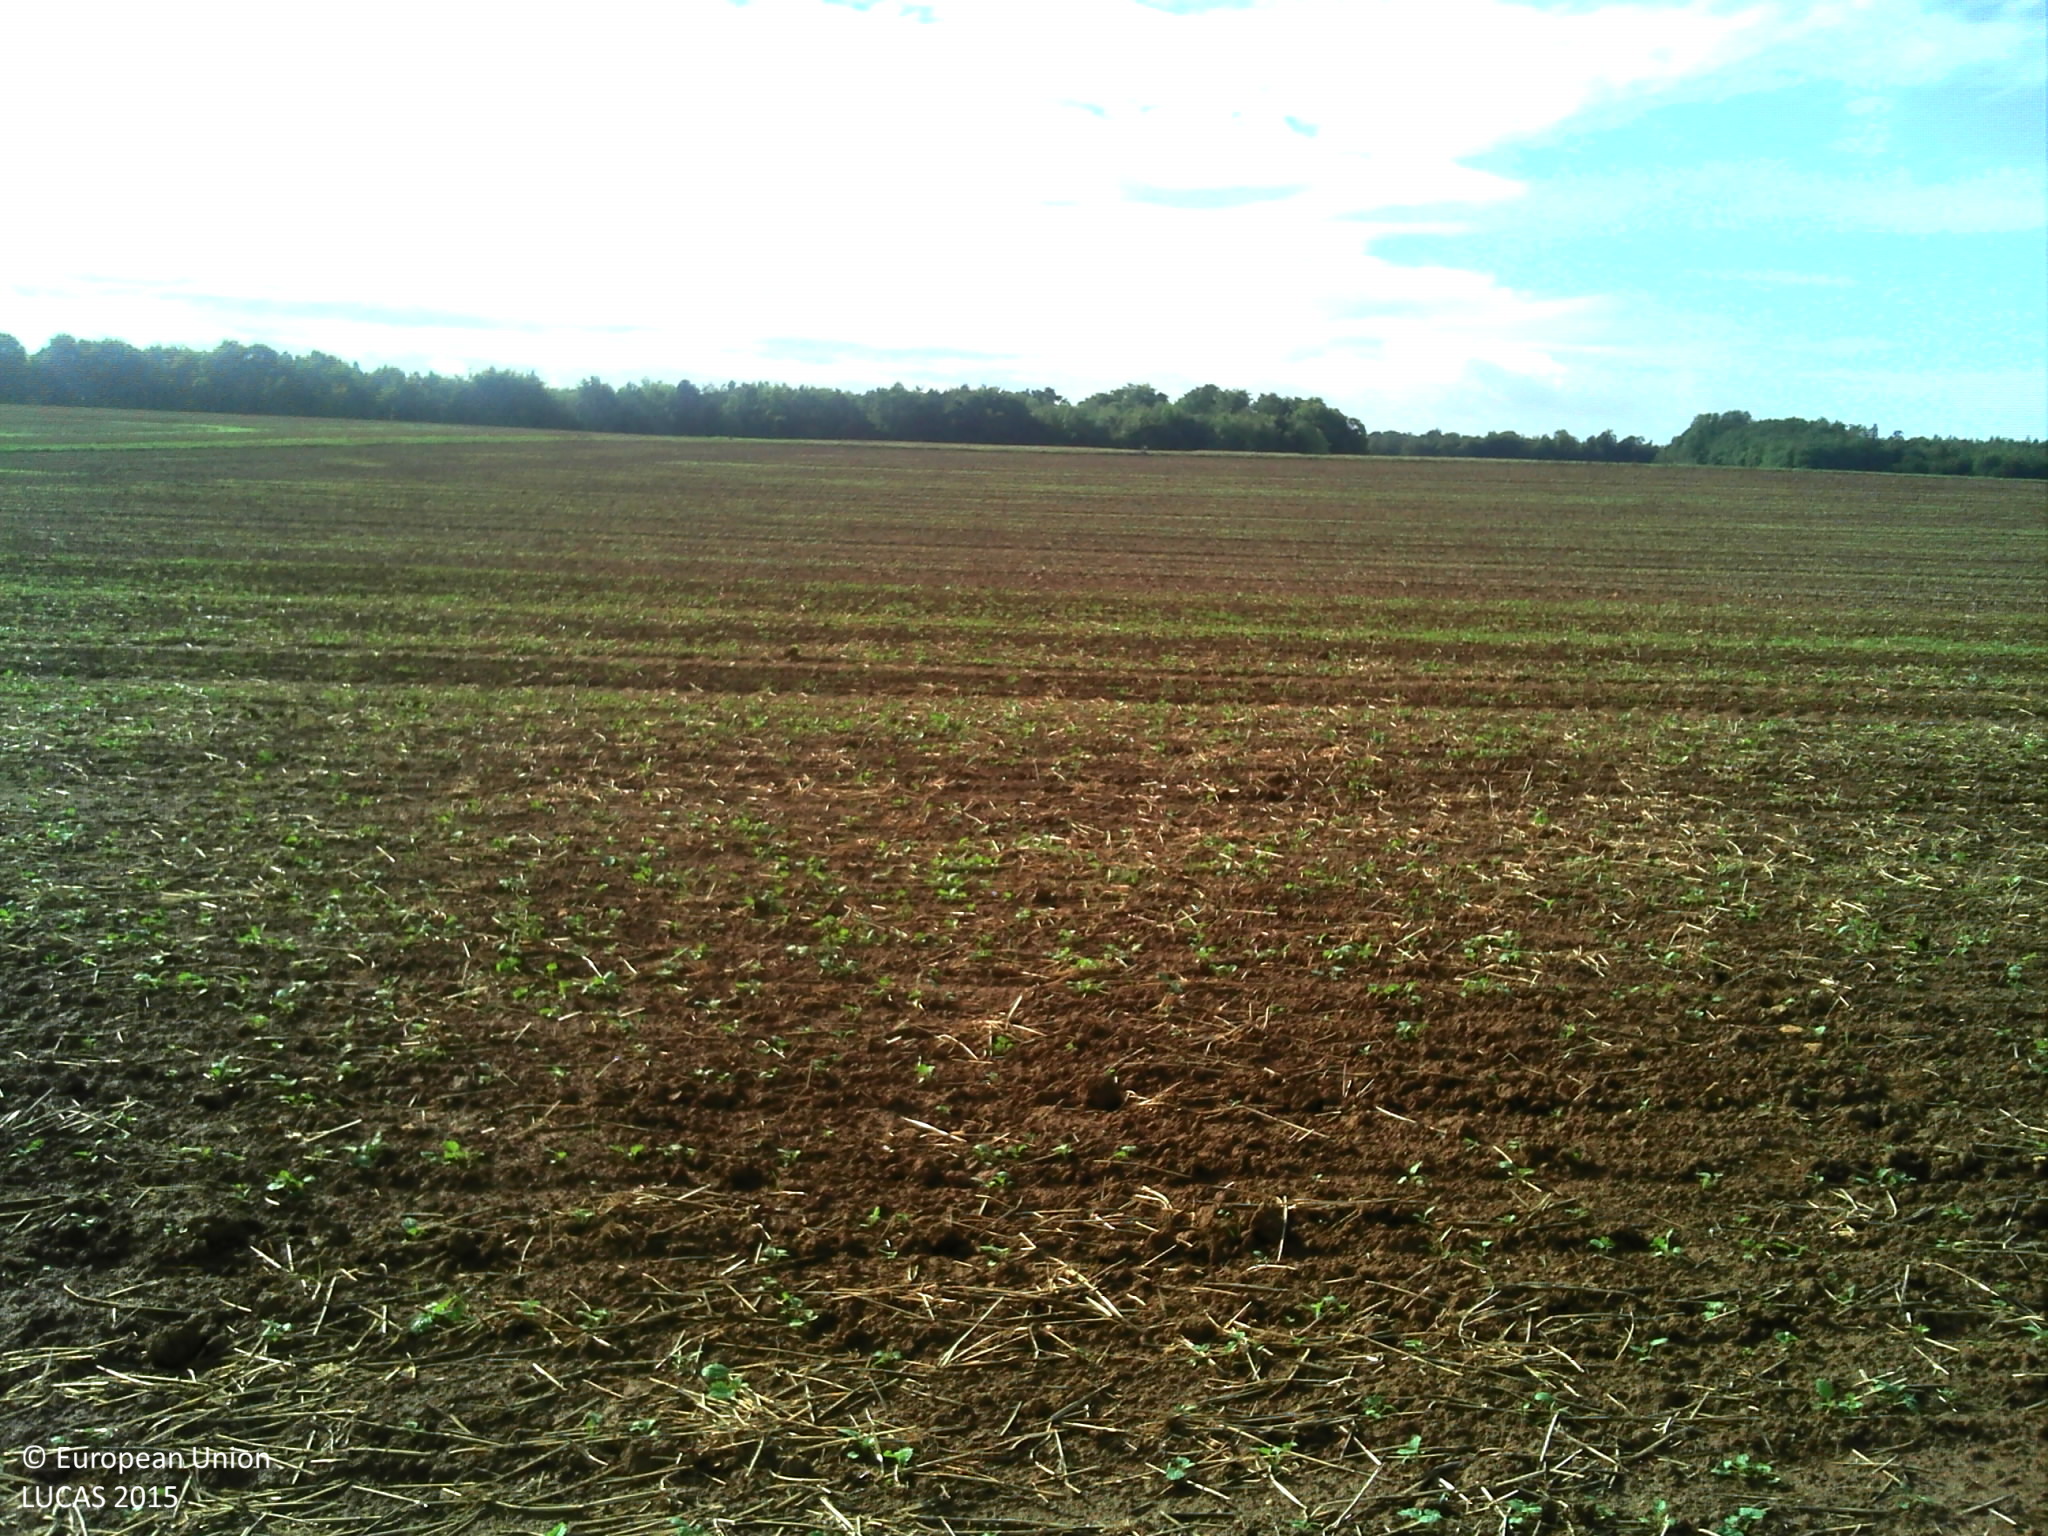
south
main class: Cropland
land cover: Other fibre and oleaginous crops
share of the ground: < 10 %
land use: Agriculture (excluding fallow land and kitchen gardens)
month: September
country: FR
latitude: 48.8179
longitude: 6.0093
